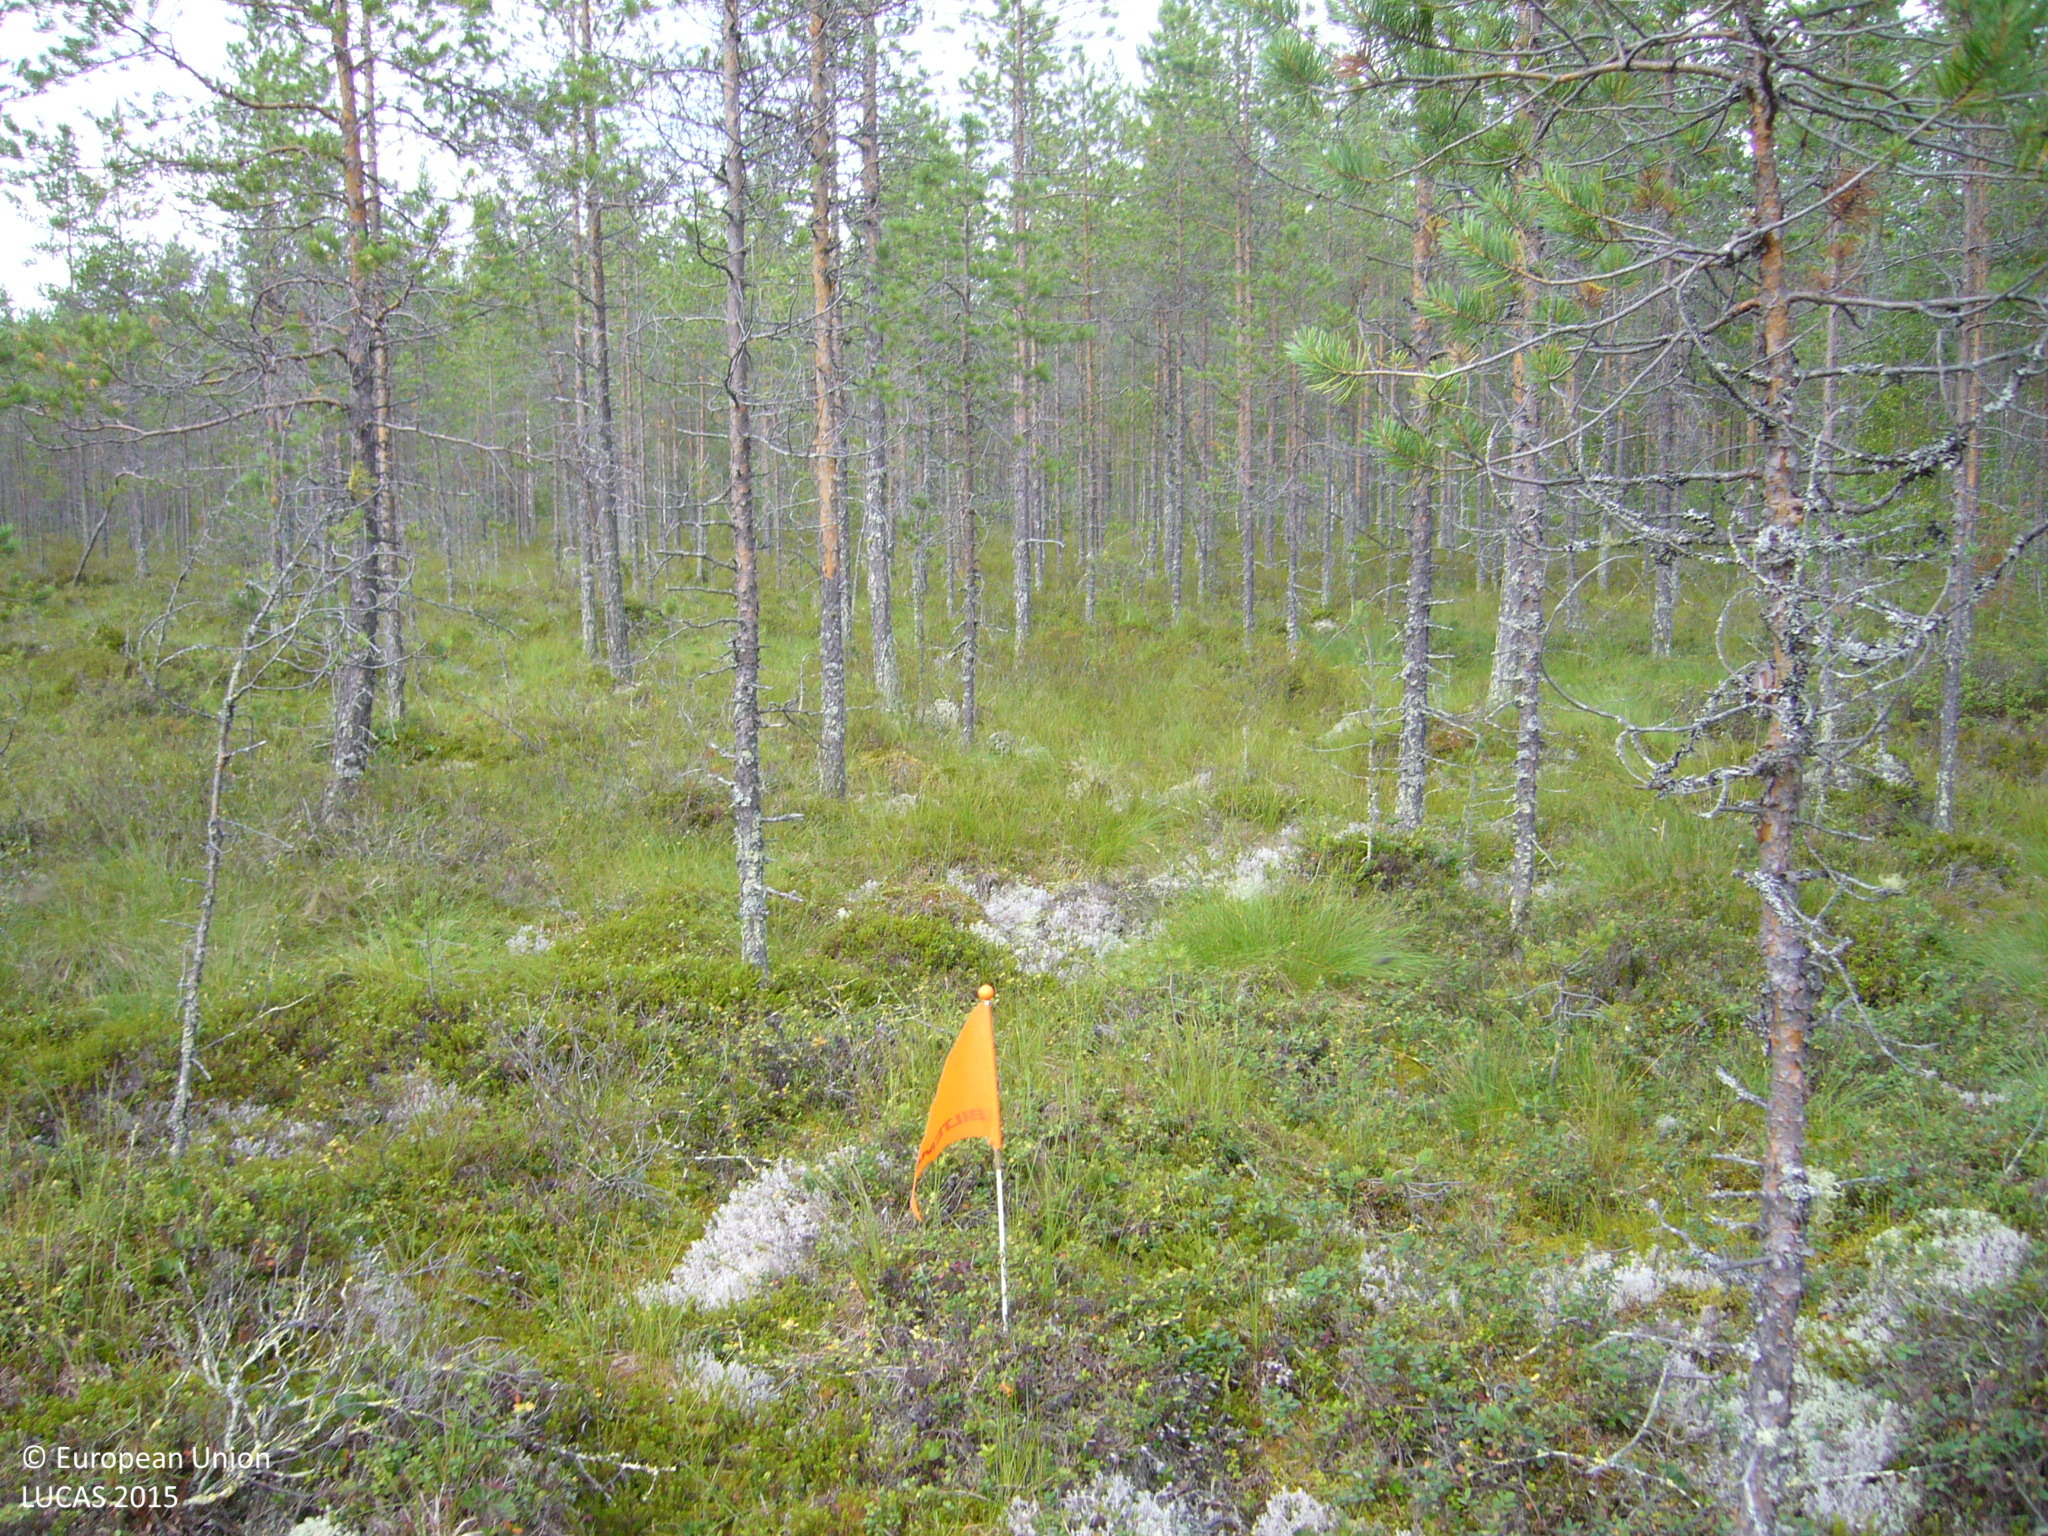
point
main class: Woodland
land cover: Pine dominated coniferous woodland
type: boreal forest
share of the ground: 50 - 75 %
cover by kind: coniferous forest trees 50 %, lichens and mosses 30 %, shrubs 20 %
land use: Forestry
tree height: > 5 m
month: July
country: FI
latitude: 64.1011
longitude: 26.1361
